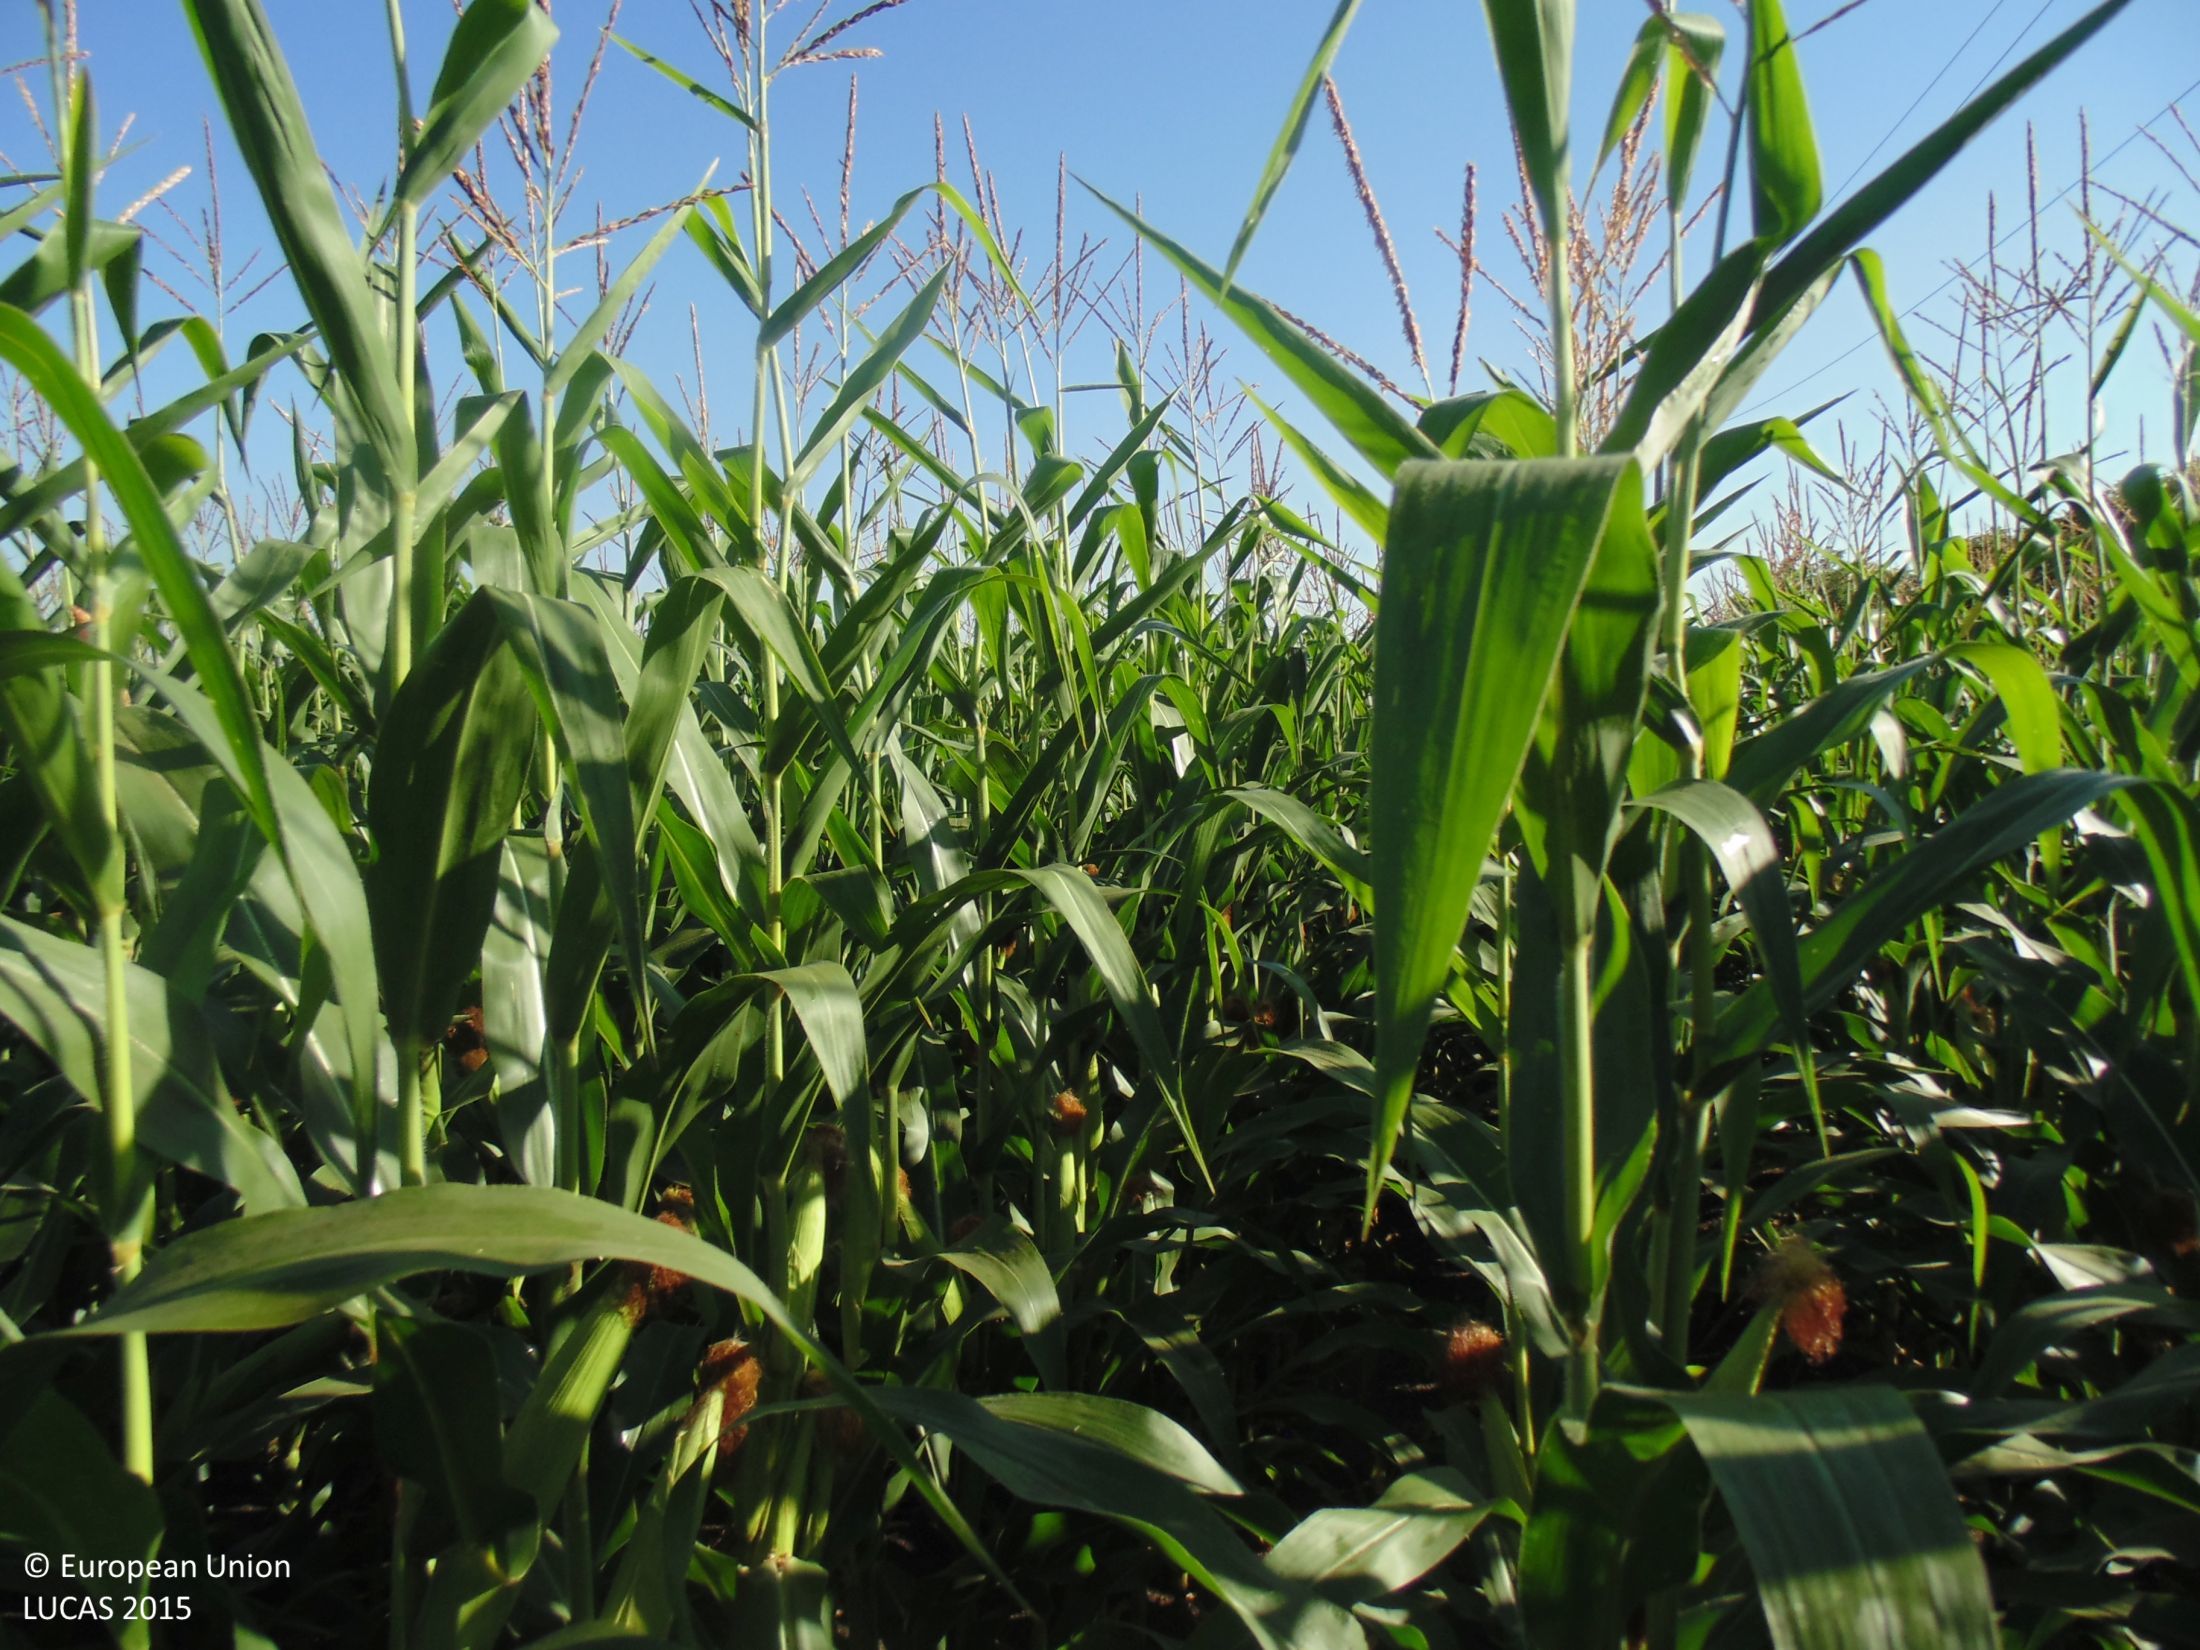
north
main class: Cropland
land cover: Maize
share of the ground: > 75 %
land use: Agriculture (excluding fallow land and kitchen gardens)
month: July
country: BG
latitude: 43.5479
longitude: 28.0323
